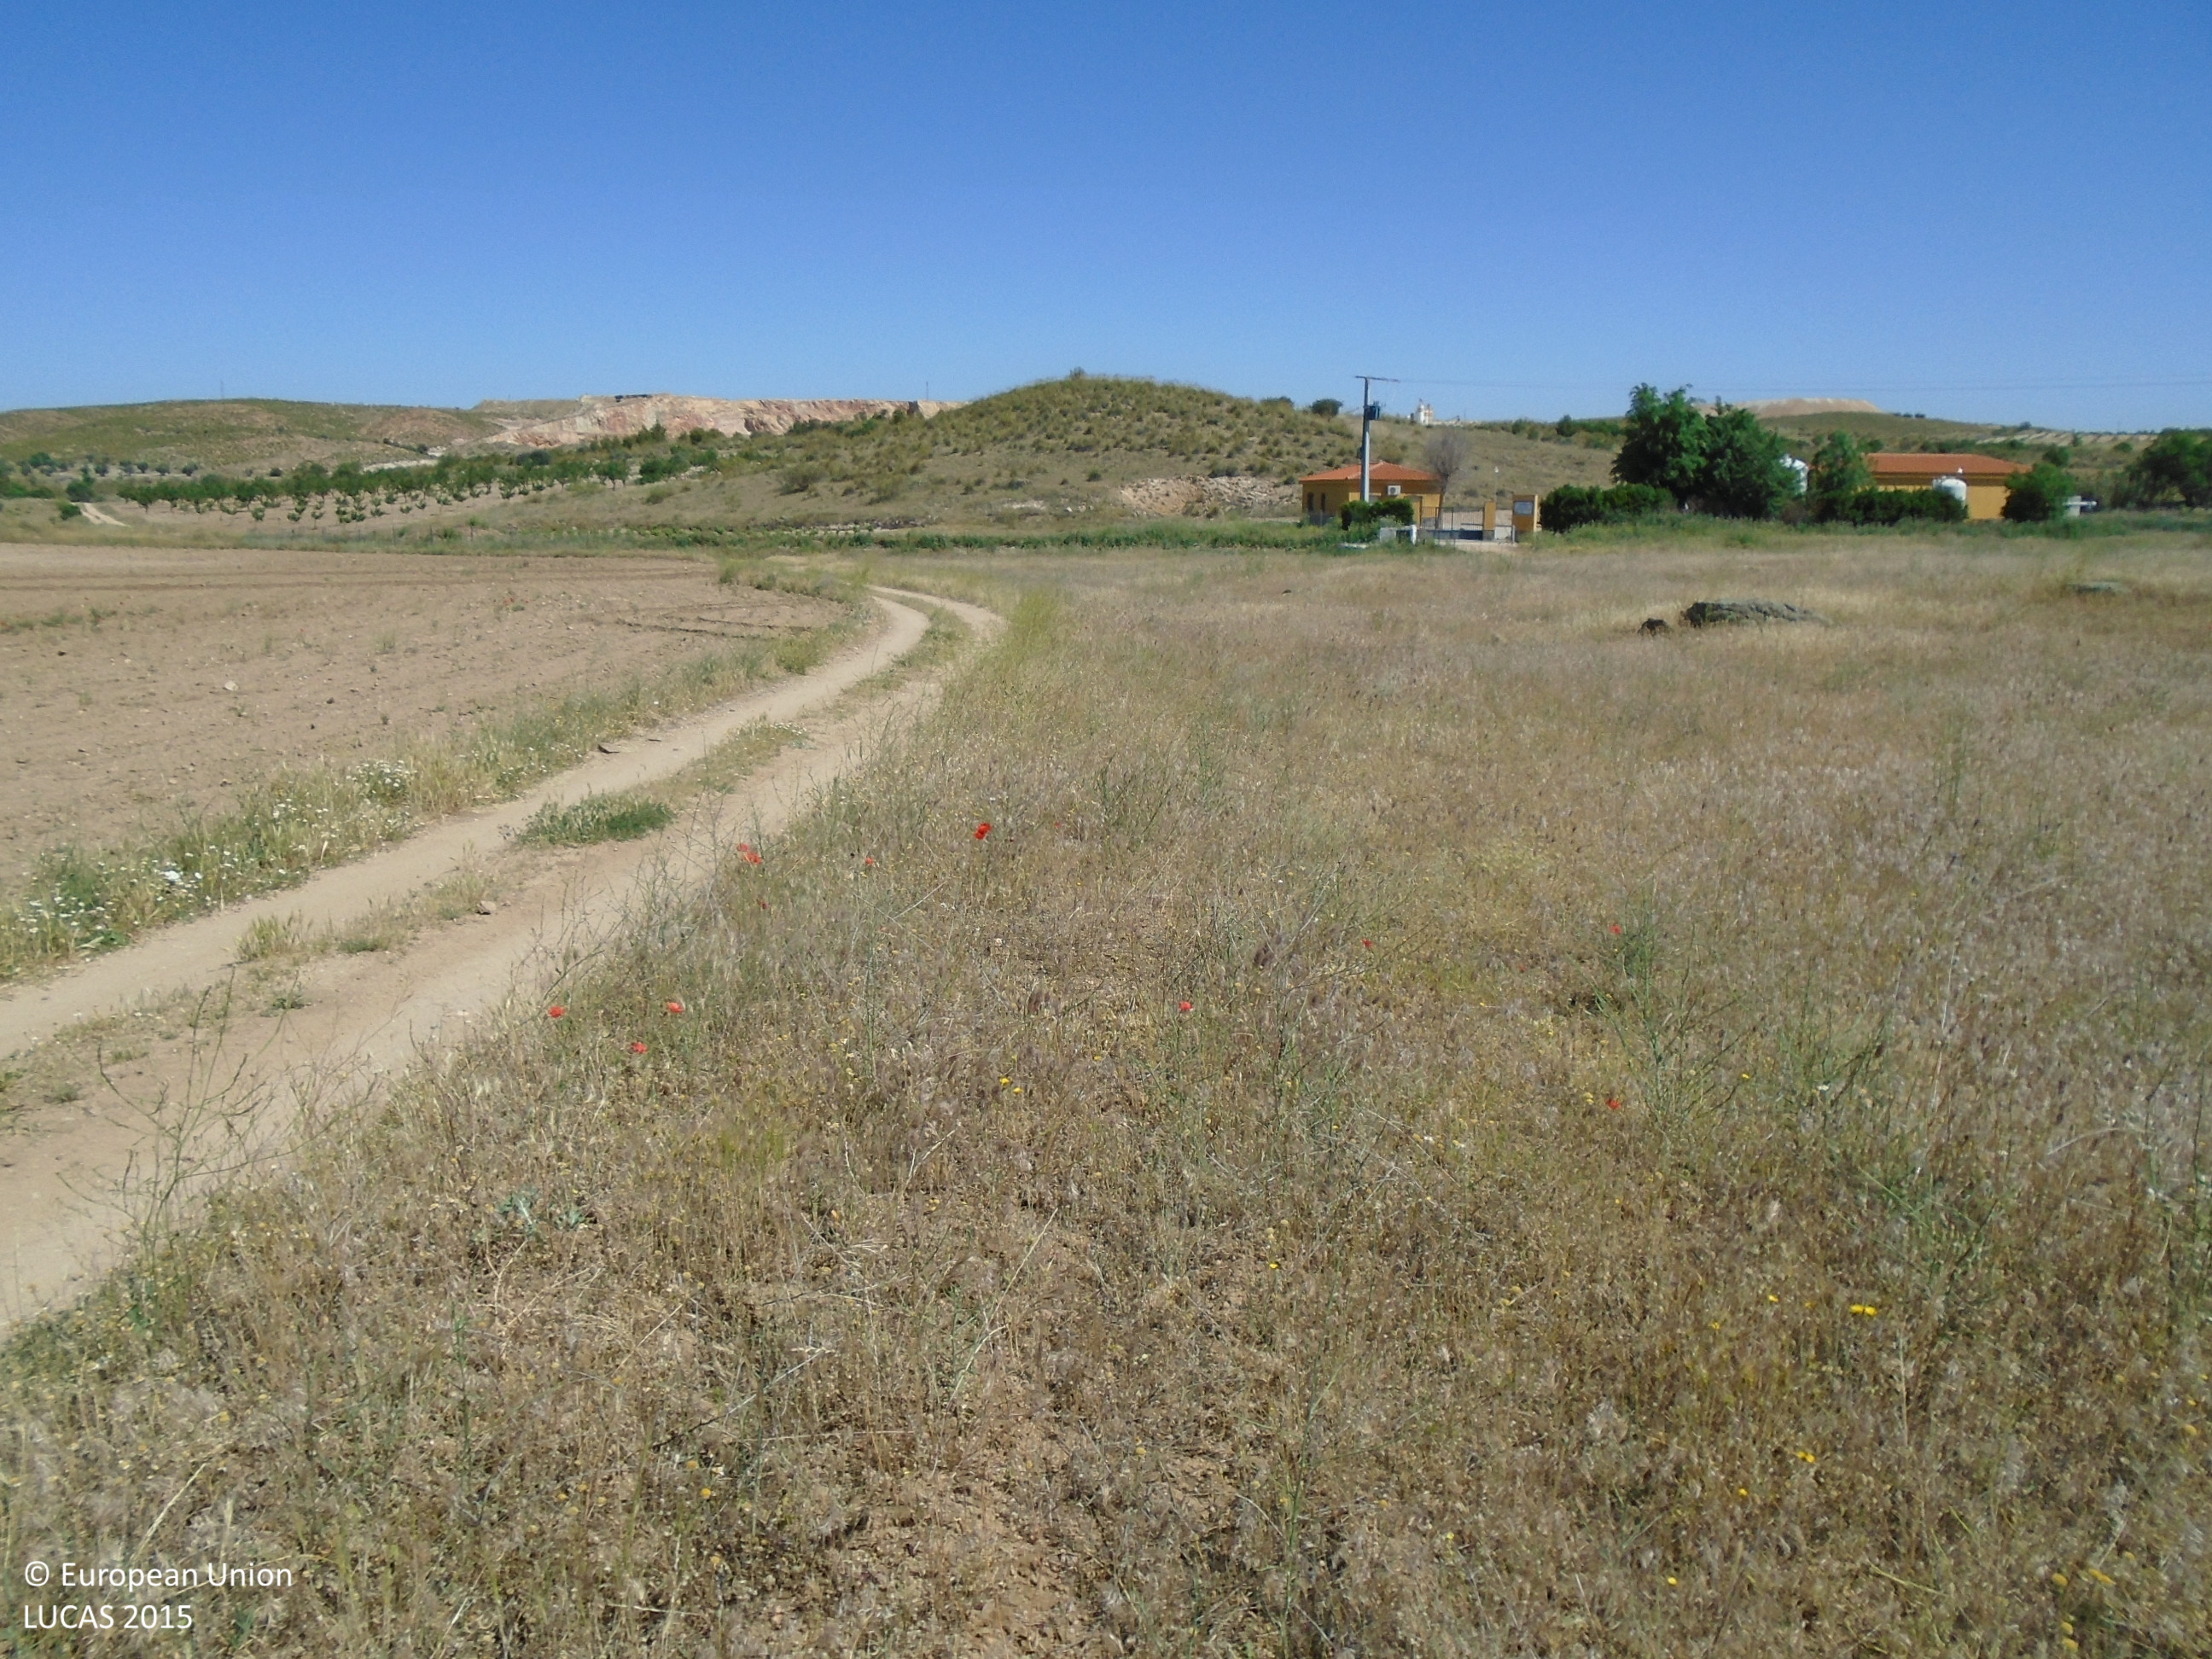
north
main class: Grassland
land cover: Spontaneously vegetated surfaces
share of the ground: > 75 %
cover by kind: herbaceous plants 100 %
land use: Fallow land
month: May
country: ES
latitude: 39.7274
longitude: -3.6666
